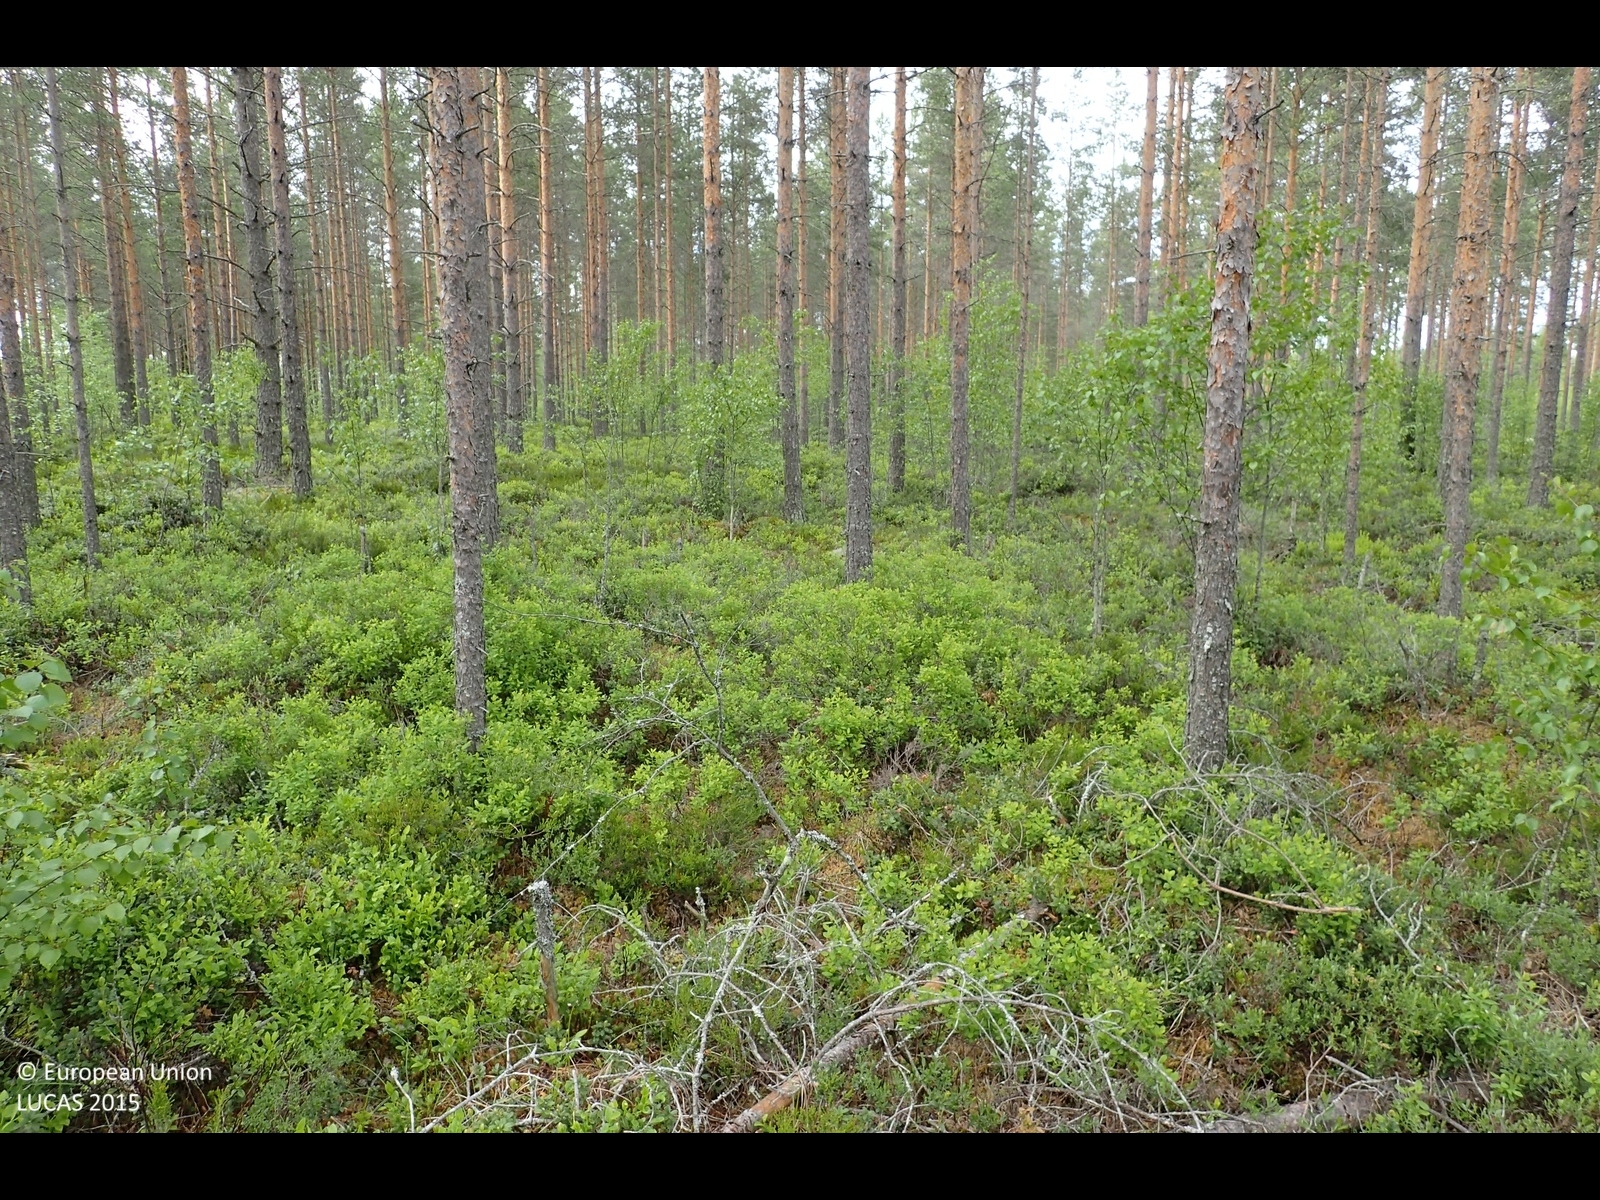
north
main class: Woodland
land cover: Pine dominated coniferous woodland
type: boreal forest
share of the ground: 25 - 50 %
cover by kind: shrubs 60 %, coniferous forest trees 35 %, broadleaved forest trees 5 %
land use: Forestry
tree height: > 5 m
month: June
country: FI
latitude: 62.4045
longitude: 23.0882
